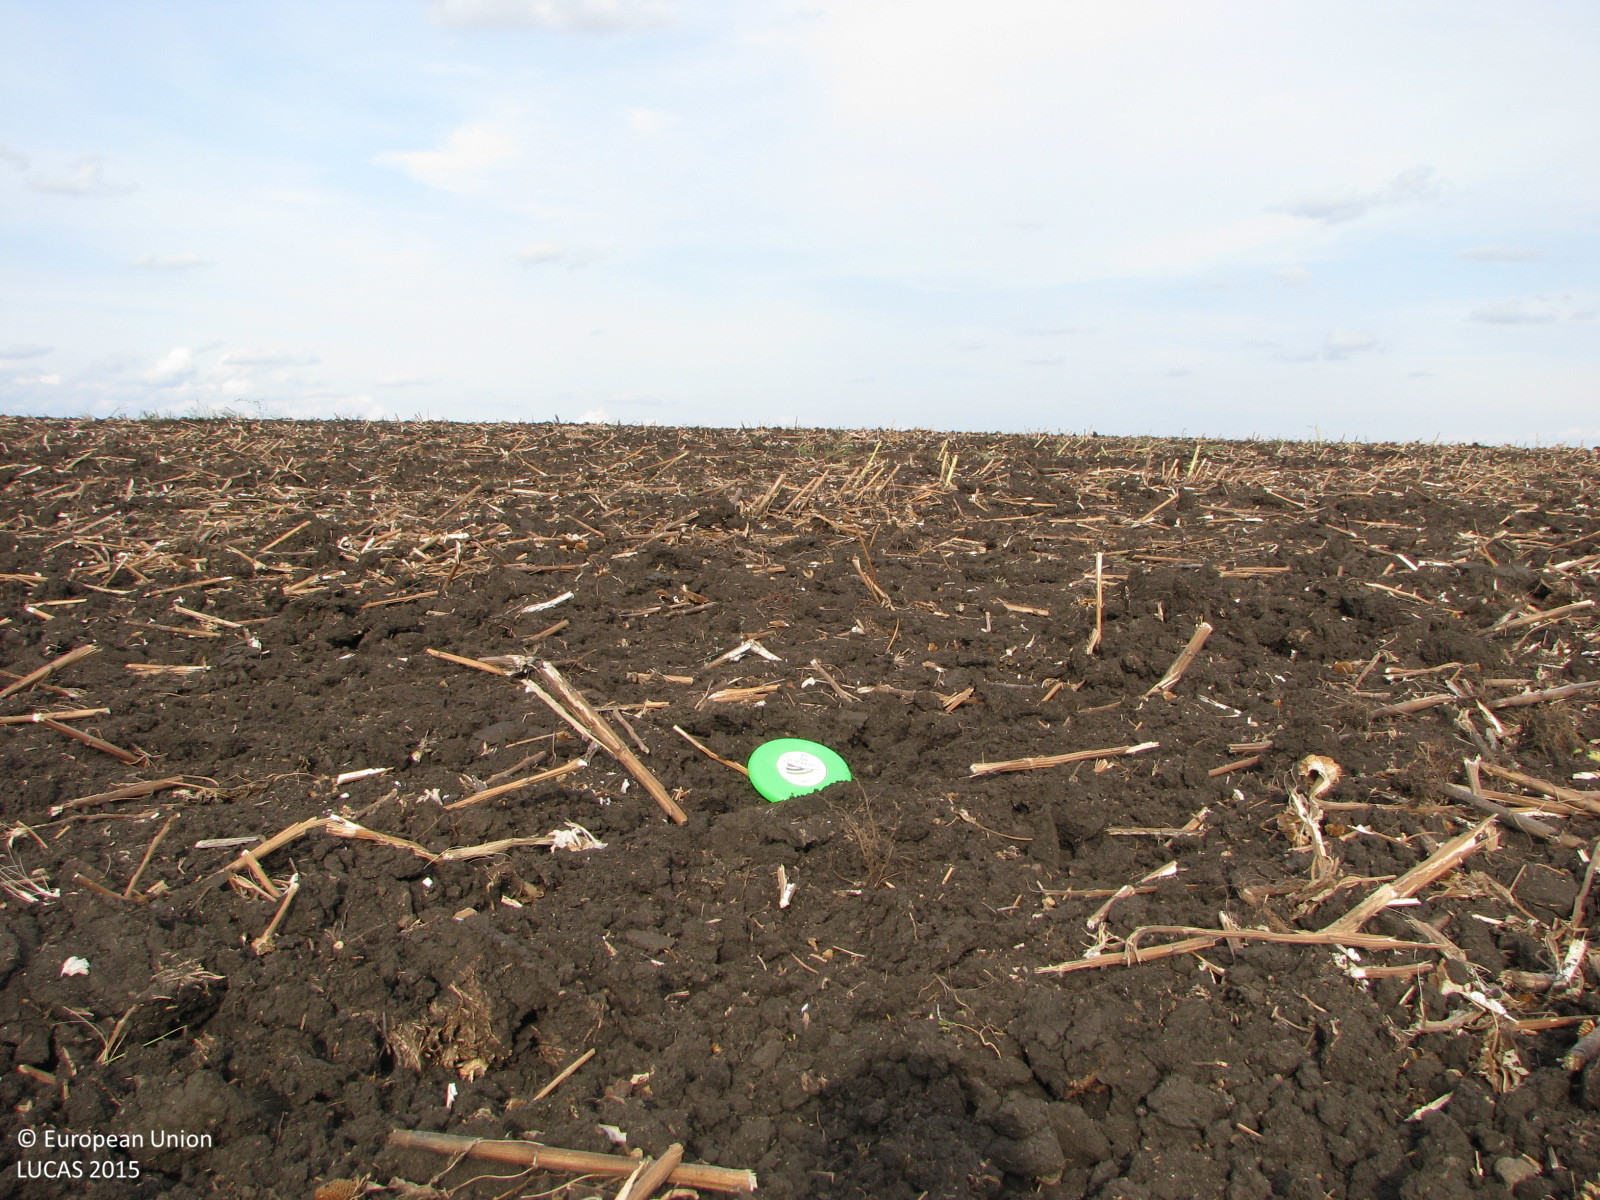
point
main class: Cropland
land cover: Sunflower
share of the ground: < 10 %
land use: Agriculture (excluding fallow land and kitchen gardens)
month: September
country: BG
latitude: 42.4427
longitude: 26.8656
